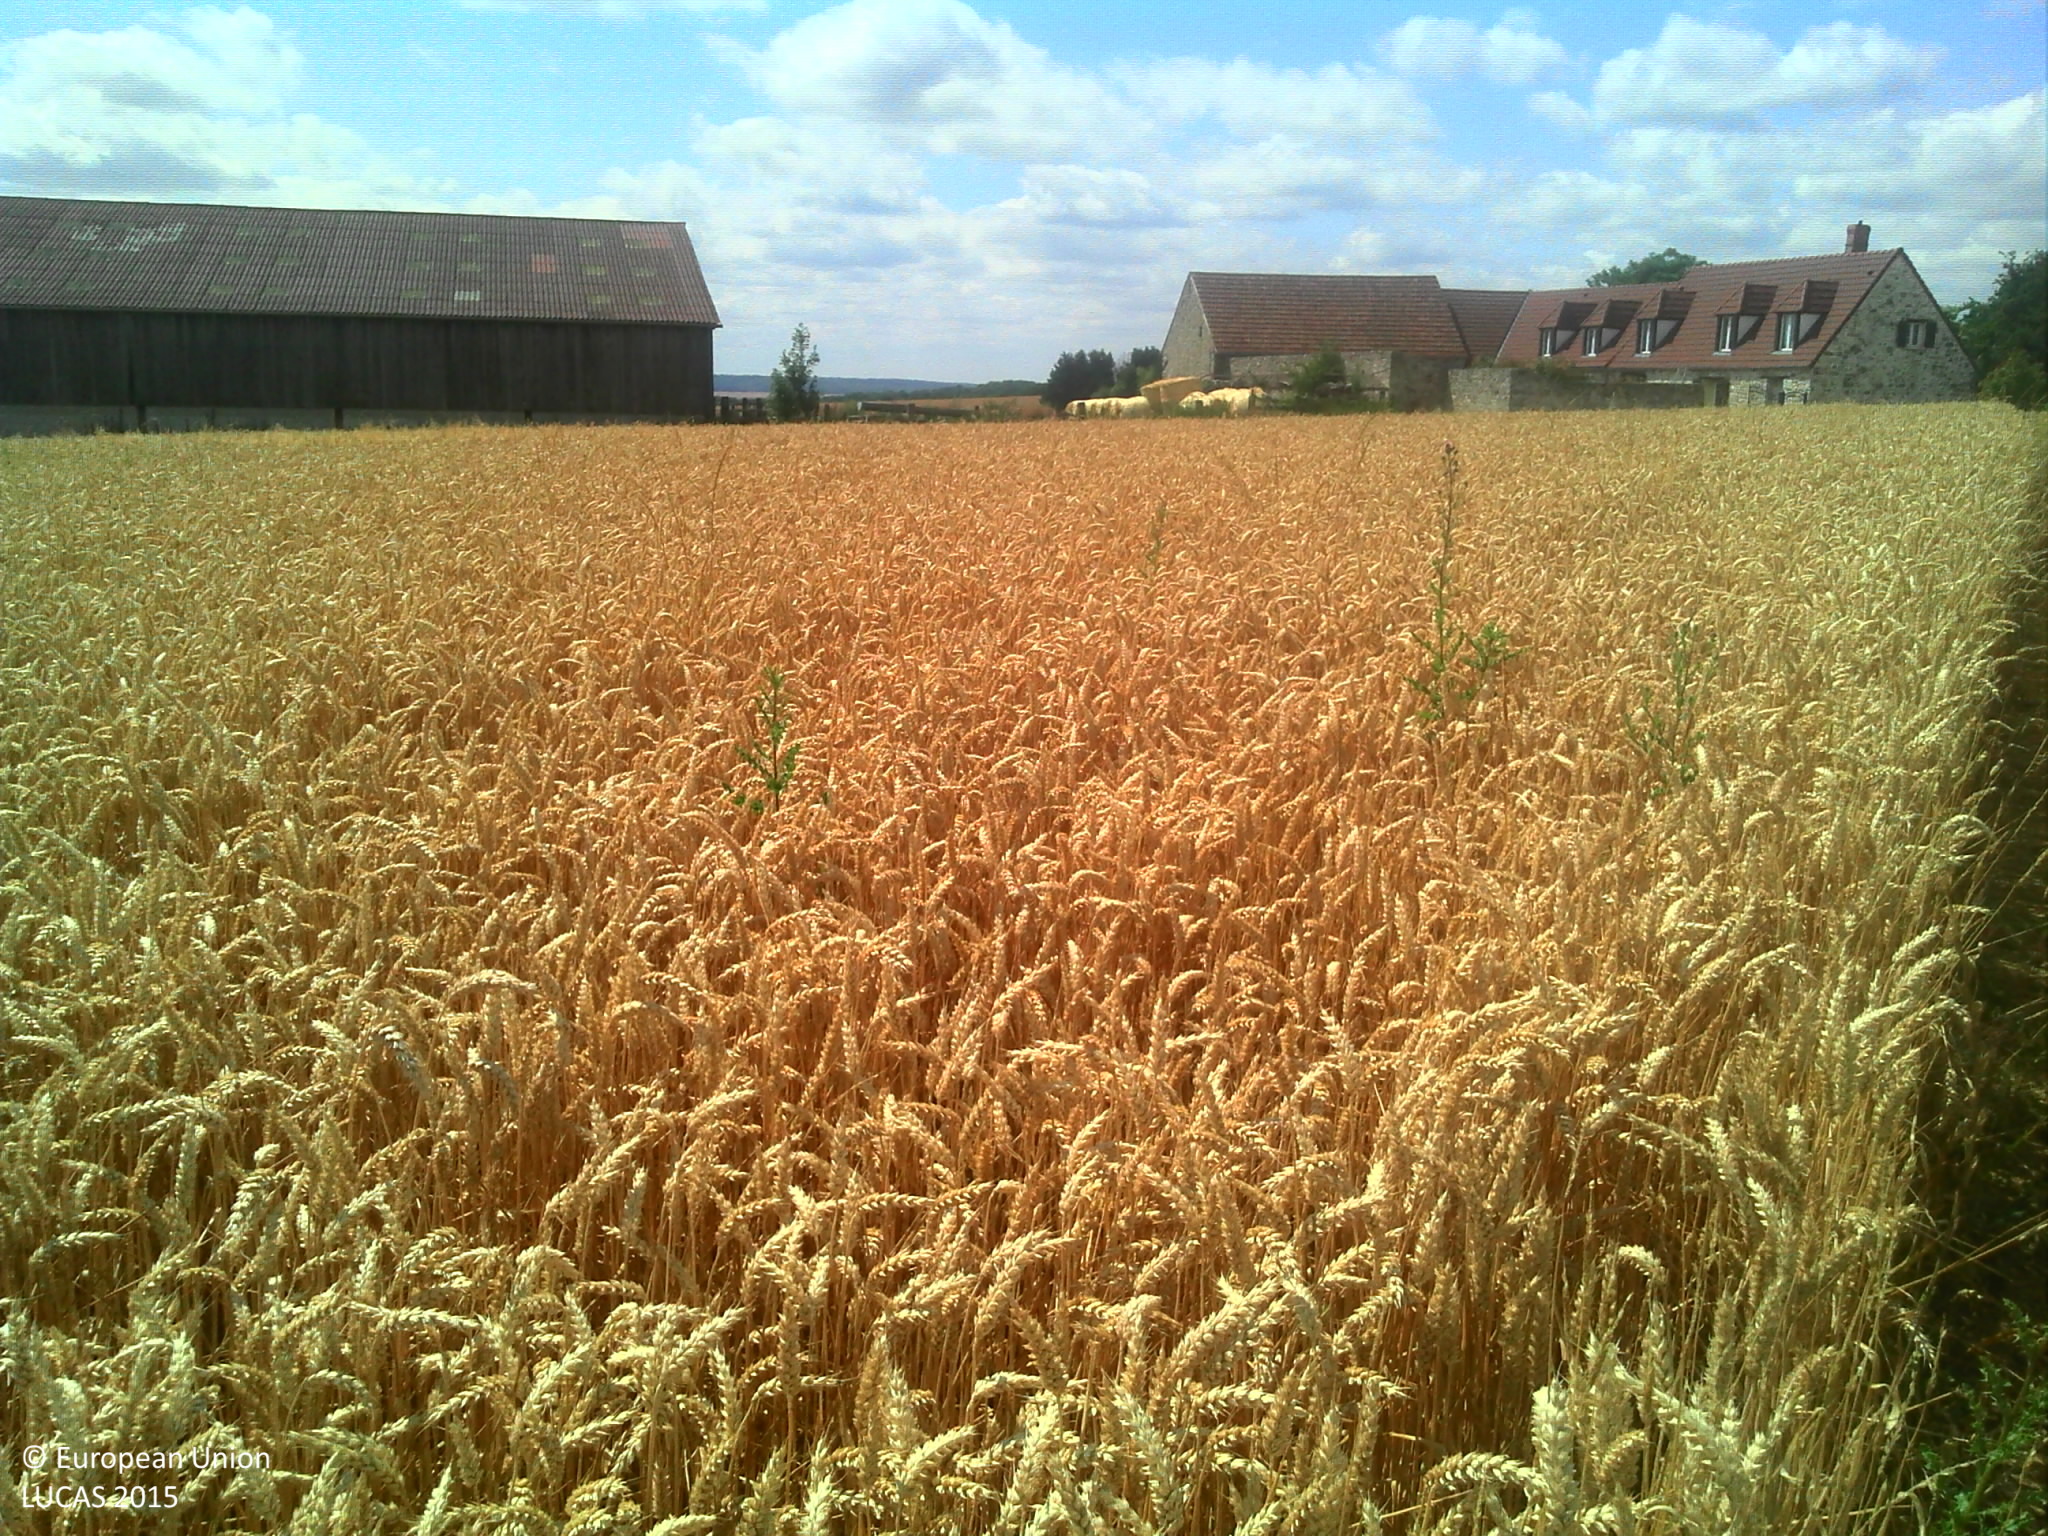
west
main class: Cropland
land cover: Common wheat
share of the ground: > 75 %
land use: Agriculture (excluding fallow land and kitchen gardens)
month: July
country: FR
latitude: 49.2473
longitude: 3.3022
